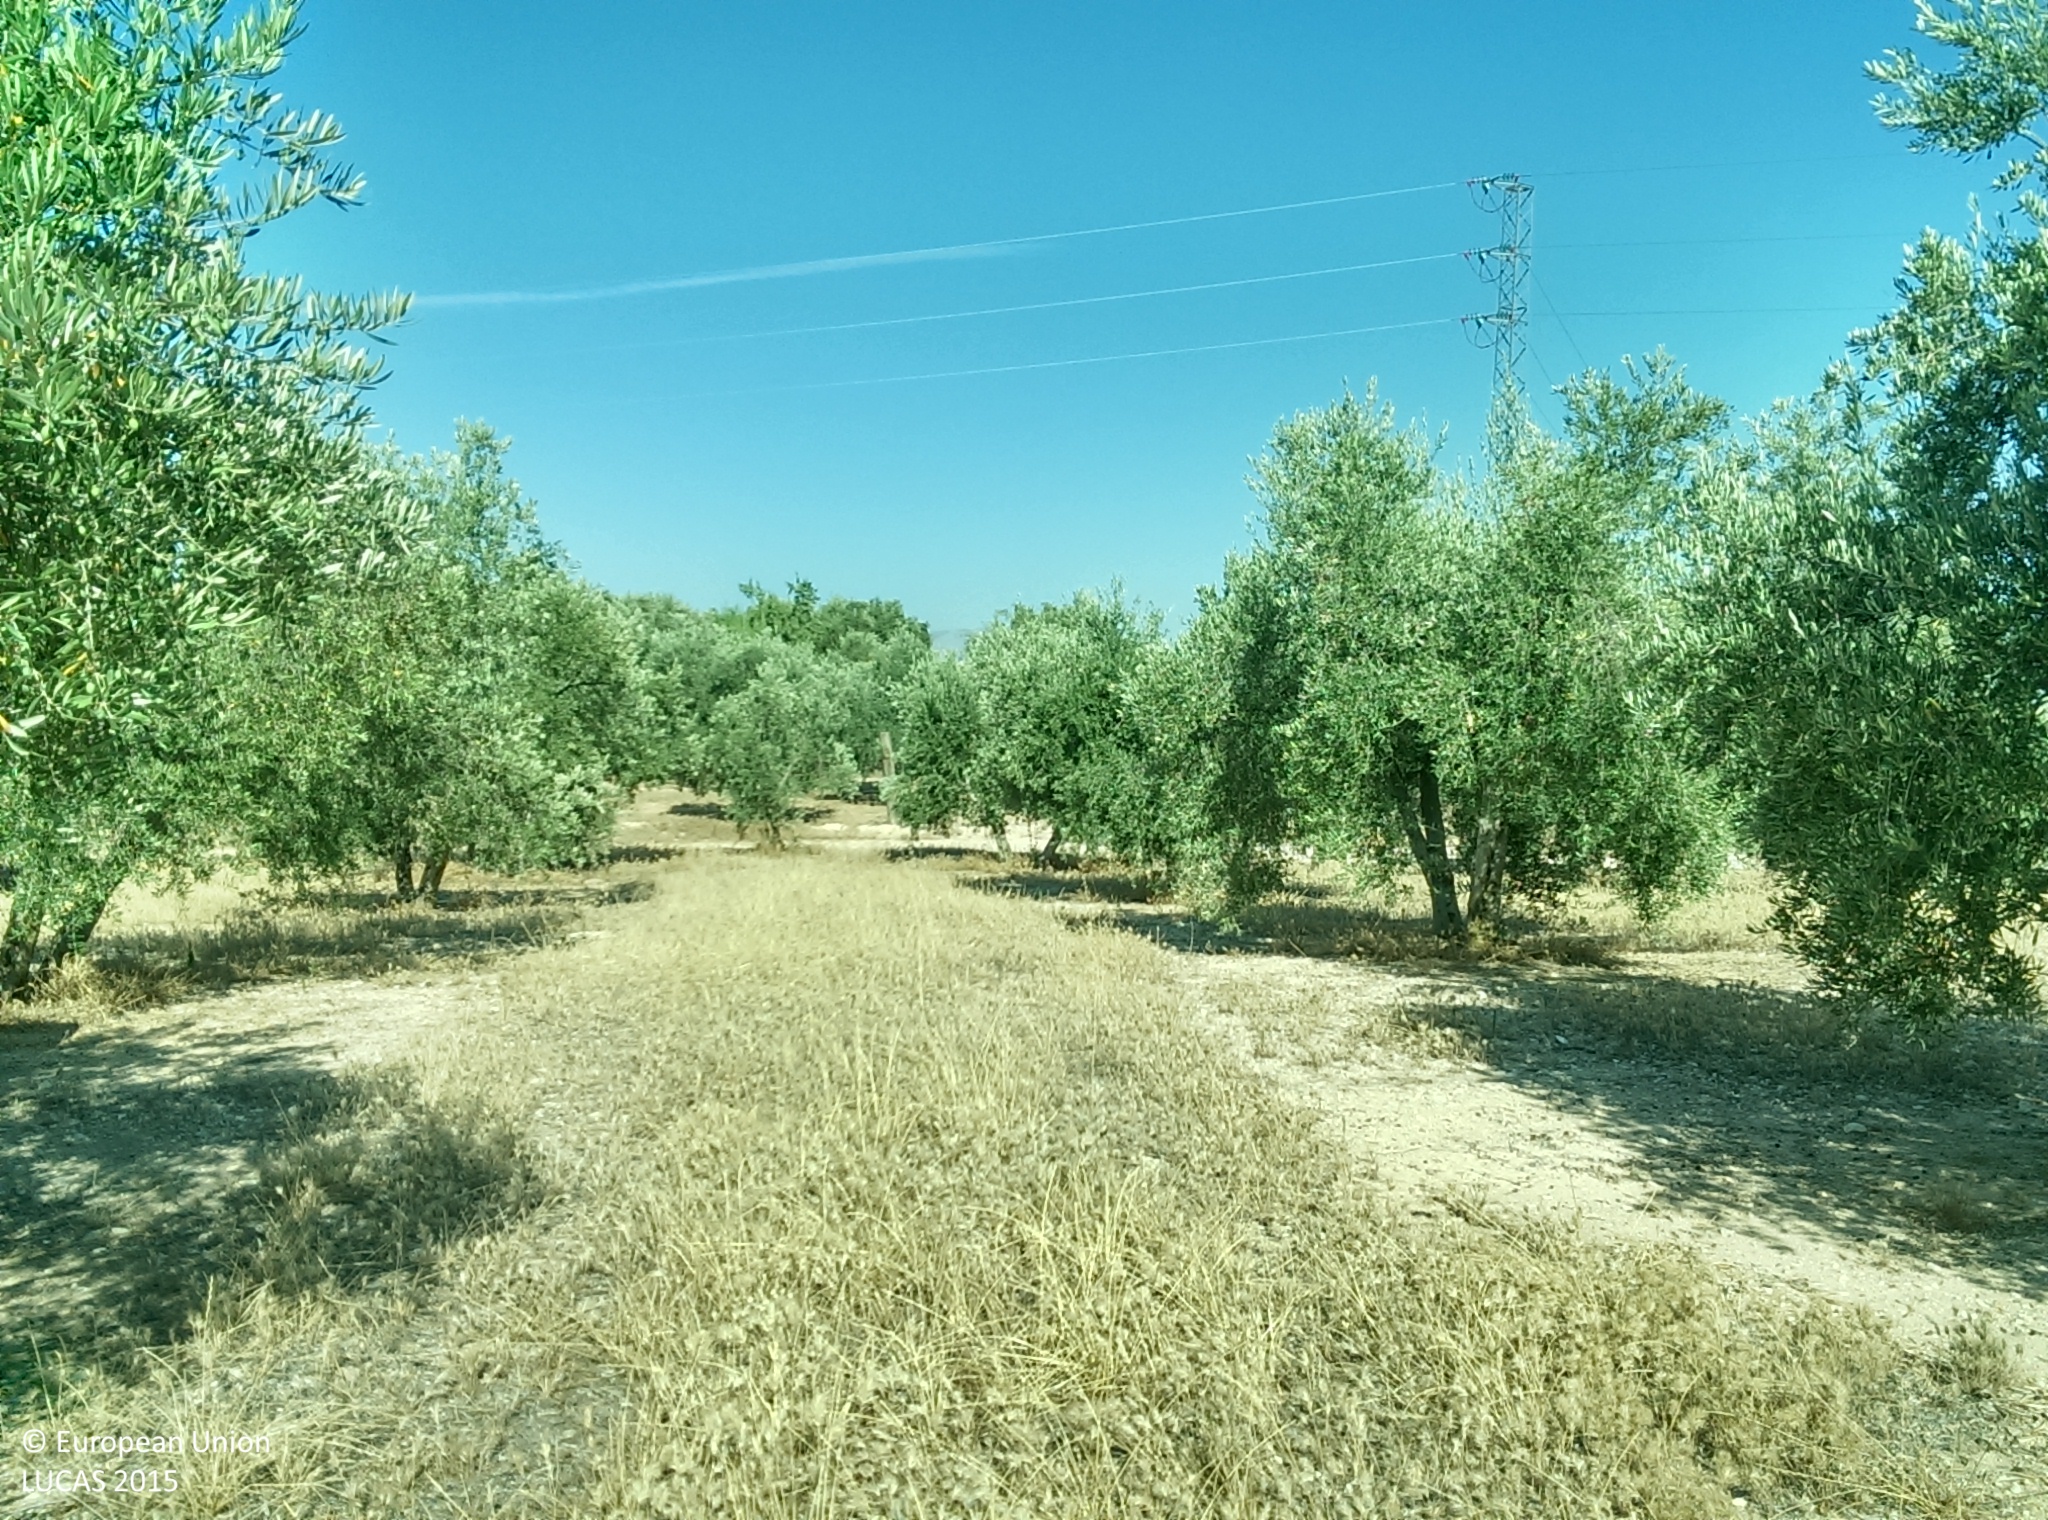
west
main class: Cropland
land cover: Olive groves
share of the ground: 25 - 50 %
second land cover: Spontaneously vegetated surfaces
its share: 25 - 50 %
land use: Agriculture (excluding fallow land and kitchen gardens)
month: July
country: ES
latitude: 37.2987
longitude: -3.7217
